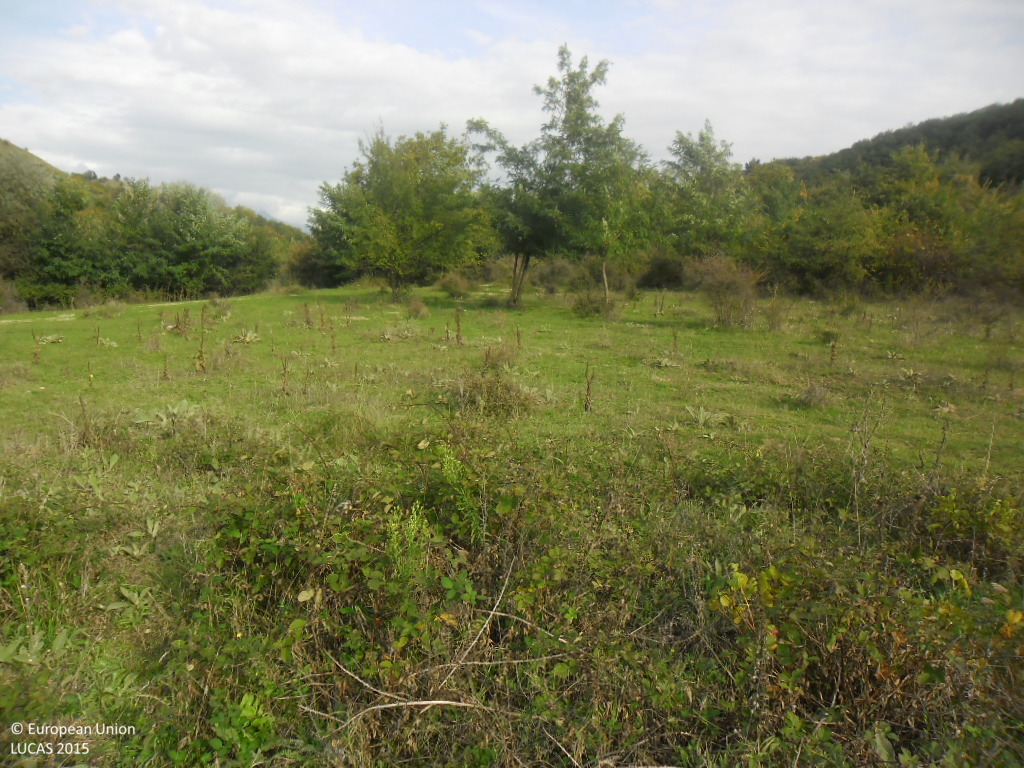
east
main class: Grassland
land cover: Grassland with sparse tree/shrub cover
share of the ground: > 75 %
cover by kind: herbaceous plants 90 %, broadleaved forest trees 5 %, shrubs 5 %
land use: Agriculture (excluding fallow land and kitchen gardens)
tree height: < 5 m
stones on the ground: < 10 %
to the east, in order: Grassland with sparse tree/shrub cover; Tracks; Grassland with sparse tree/shrub cover; Shrubland with sparse tree cover; Tracks; Broadleaved woodland; Grassland with sparse tree/shrub cover; Vineyards
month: October
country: BG
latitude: 42.0985
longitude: 23.0469
